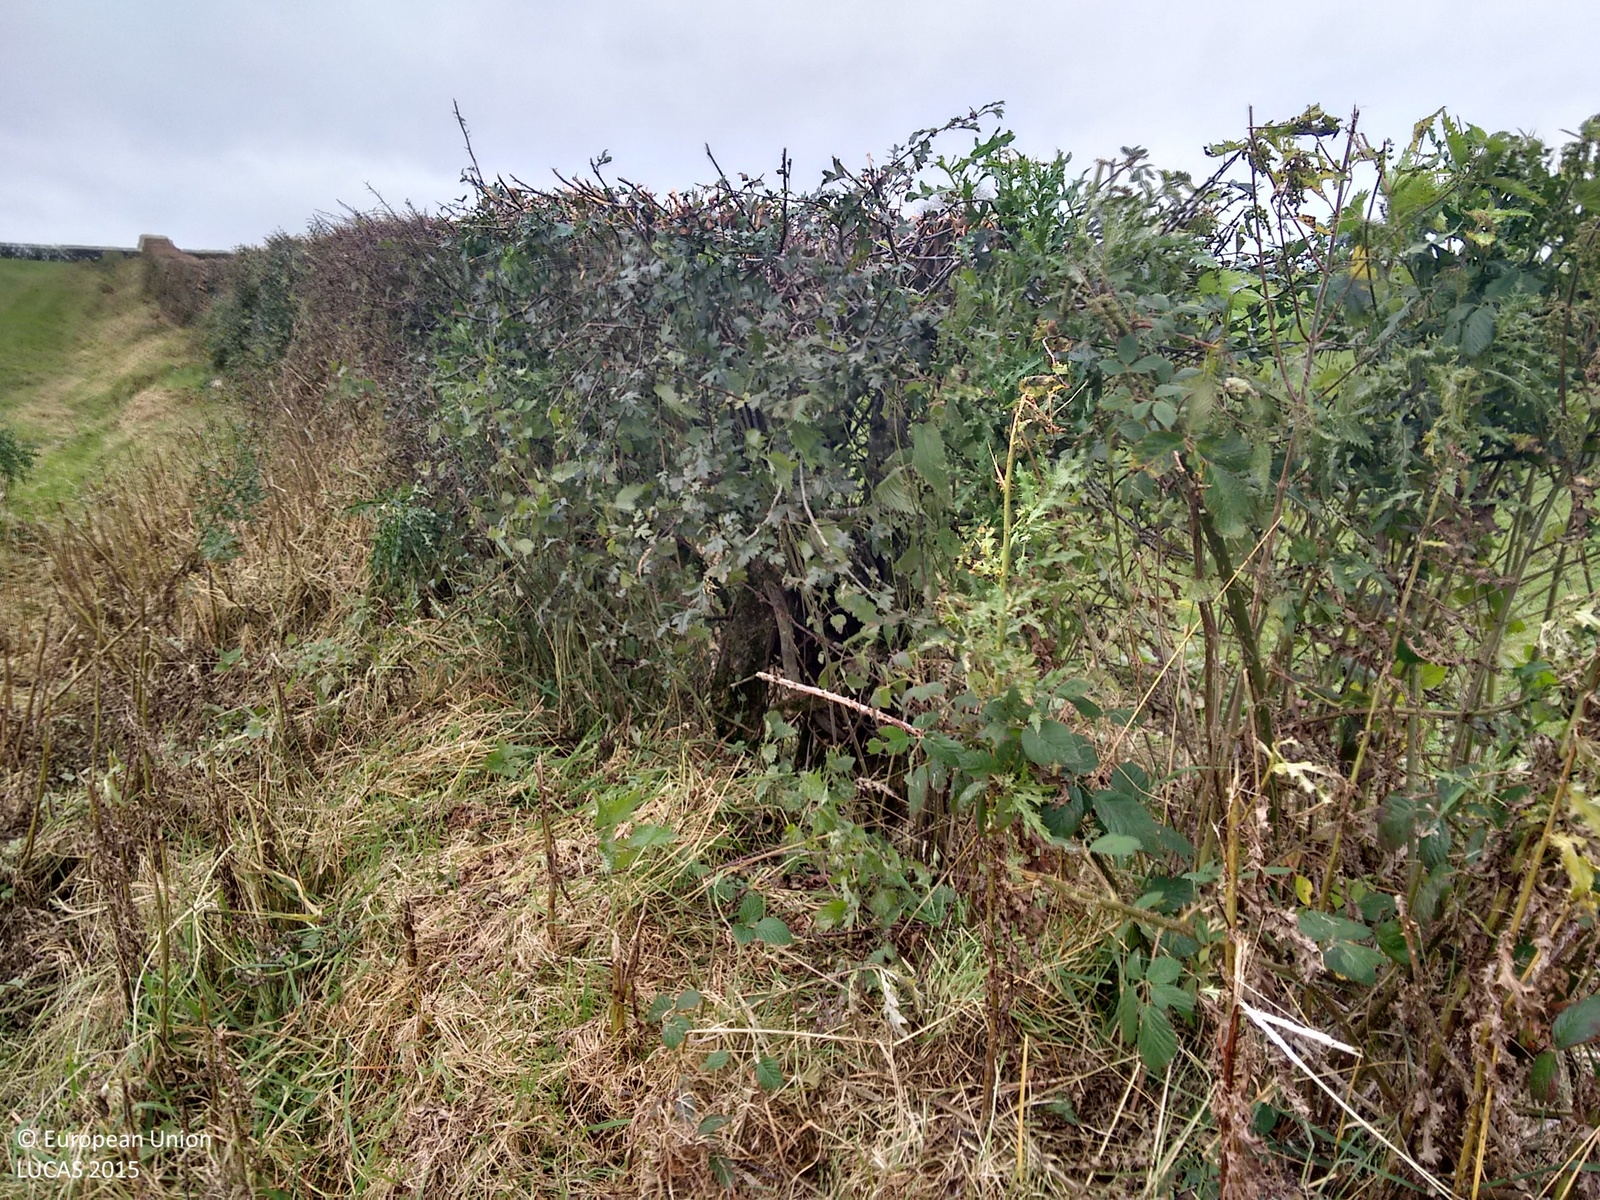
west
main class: Grassland
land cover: Grassland without tree/shrub cover
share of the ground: > 75 %
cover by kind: herbaceous plants 100 %
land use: Agriculture (excluding fallow land and kitchen gardens)
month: October
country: GB
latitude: 54.3267
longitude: -7.3577
